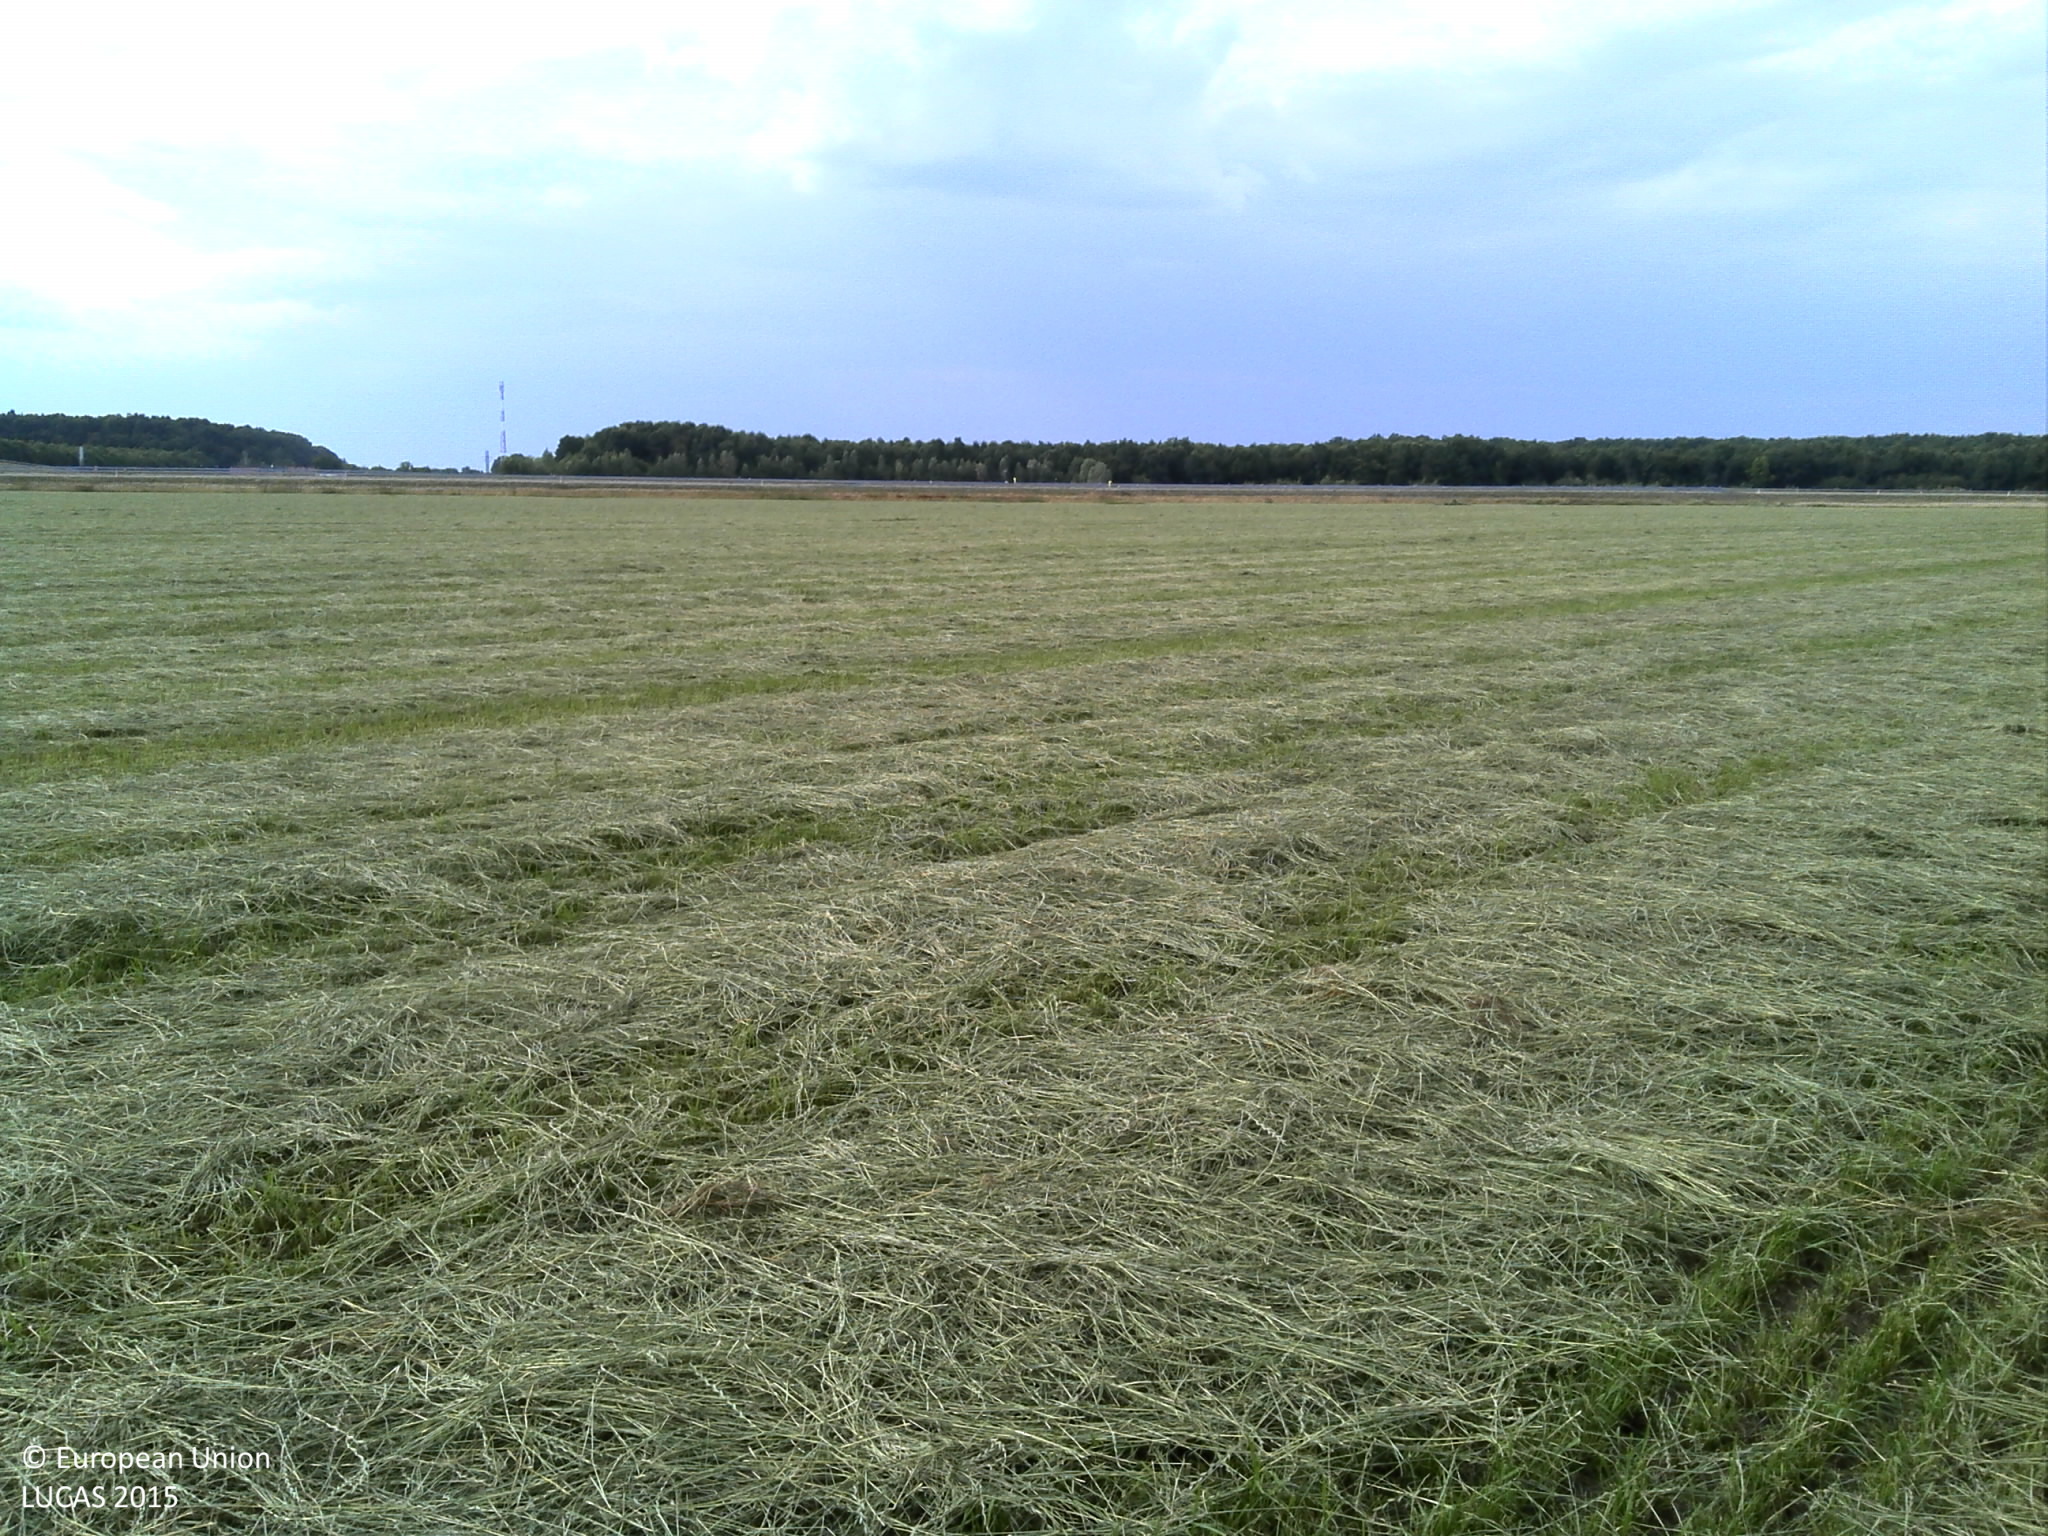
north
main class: Grassland
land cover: Grassland without tree/shrub cover
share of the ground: > 75 %
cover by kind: herbaceous plants 100 %
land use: Agriculture (excluding fallow land and kitchen gardens)
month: June
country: HR
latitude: 45.4027
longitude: 18.4247
